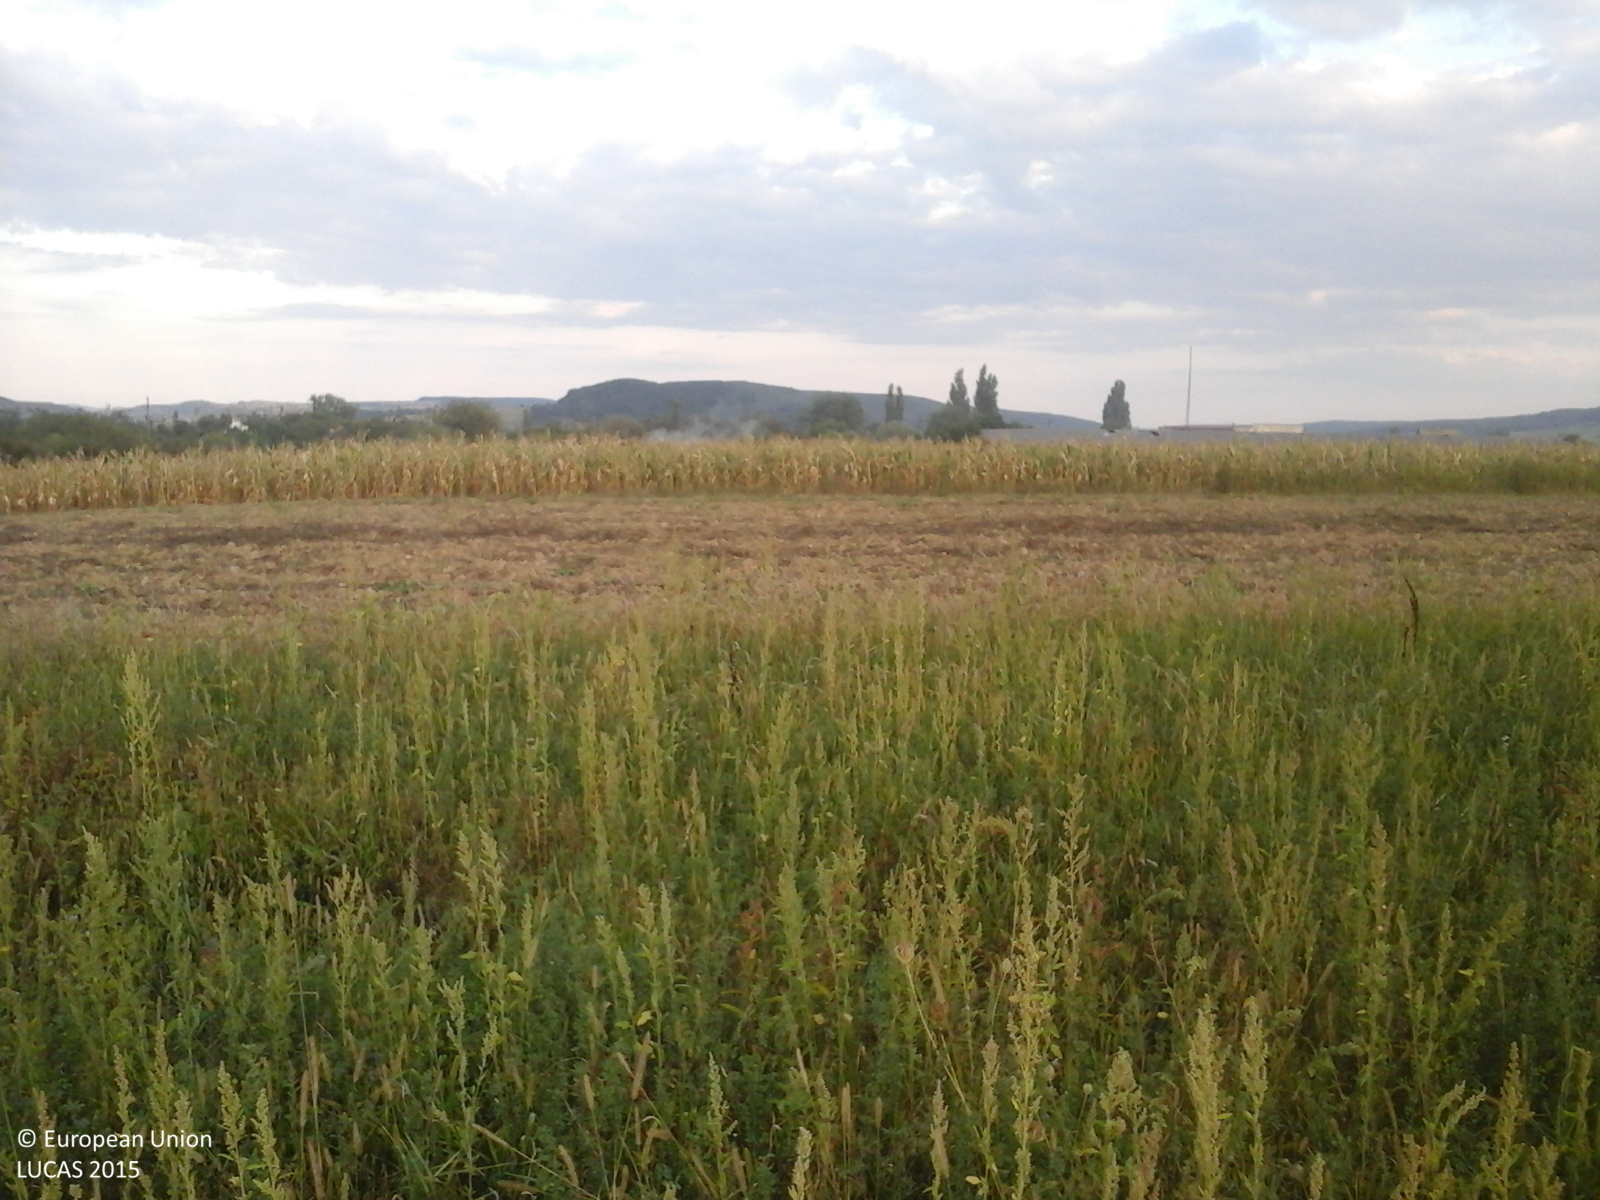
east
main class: Cropland
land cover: Lucerne
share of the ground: > 75 %
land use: Agriculture (excluding fallow land and kitchen gardens)
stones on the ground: < 10 %
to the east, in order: Lucerne; Common wheat; Grass margins; Tracks; Grass margins; Maize; Shrubland with sparse tree cover; Ditches and canals; Shrubland with sparse tree cover; Lucerne; Electric lines; Lucerne
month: September
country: RO
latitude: 47.4576
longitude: 22.7819
